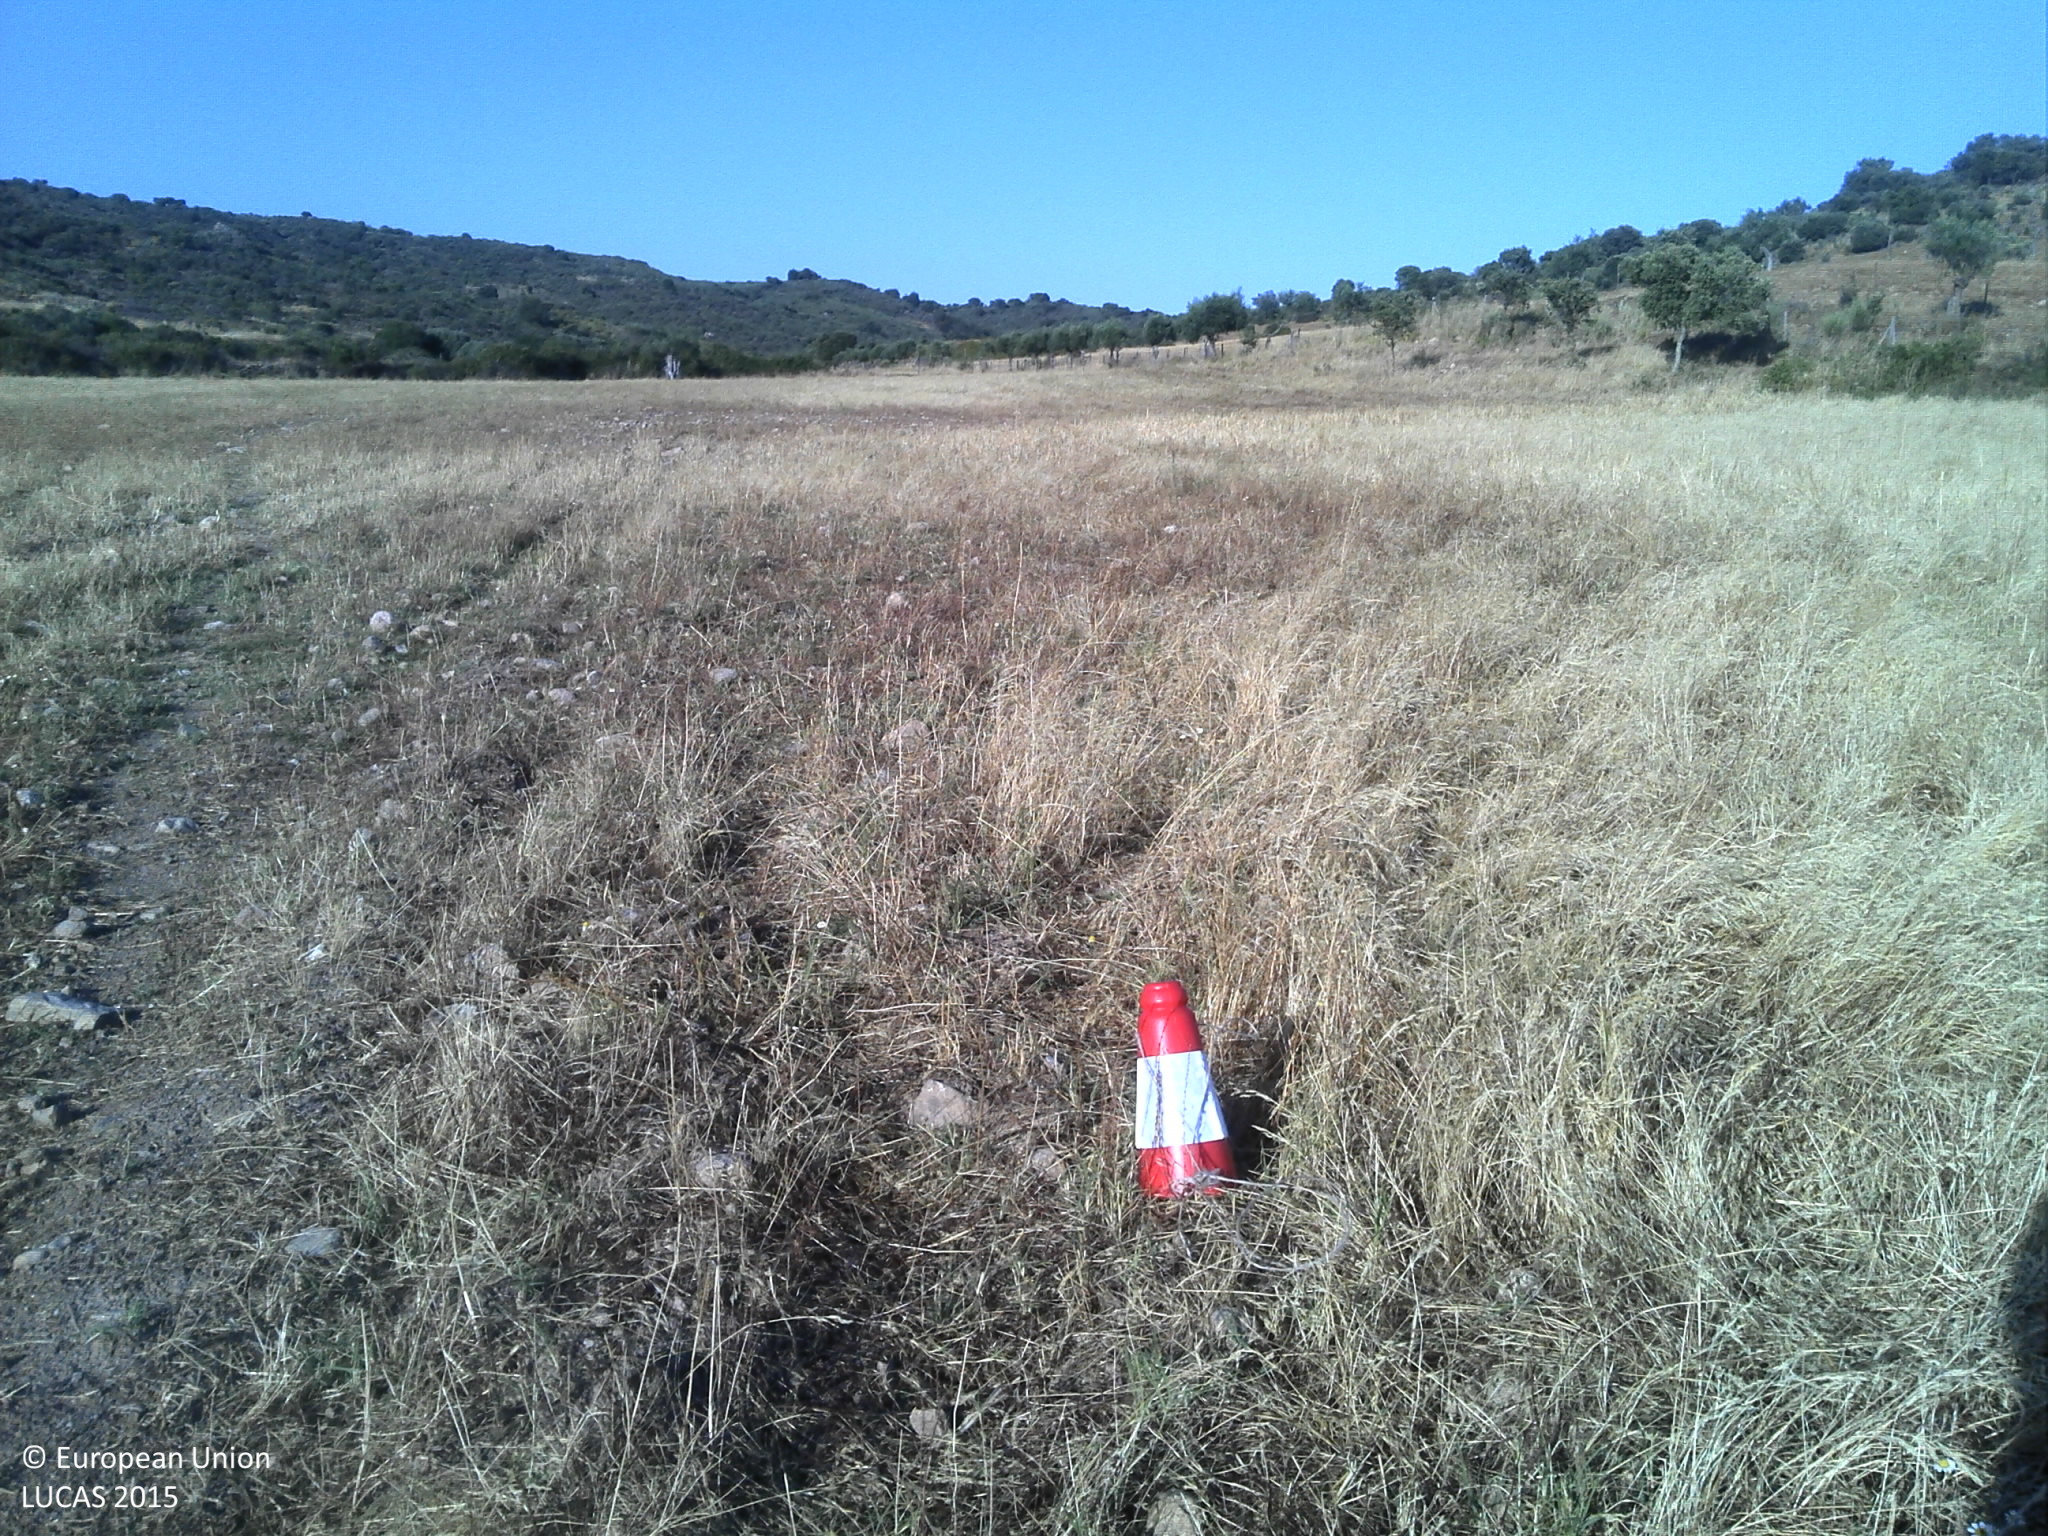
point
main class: Grassland
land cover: Grassland without tree/shrub cover
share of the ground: 50 - 75 %
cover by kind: herbaceous plants 60 %, unconsolidated bare surface 35 %
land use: Agriculture (excluding fallow land and kitchen gardens)
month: June
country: PT
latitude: 39.9901
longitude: -7.3017
